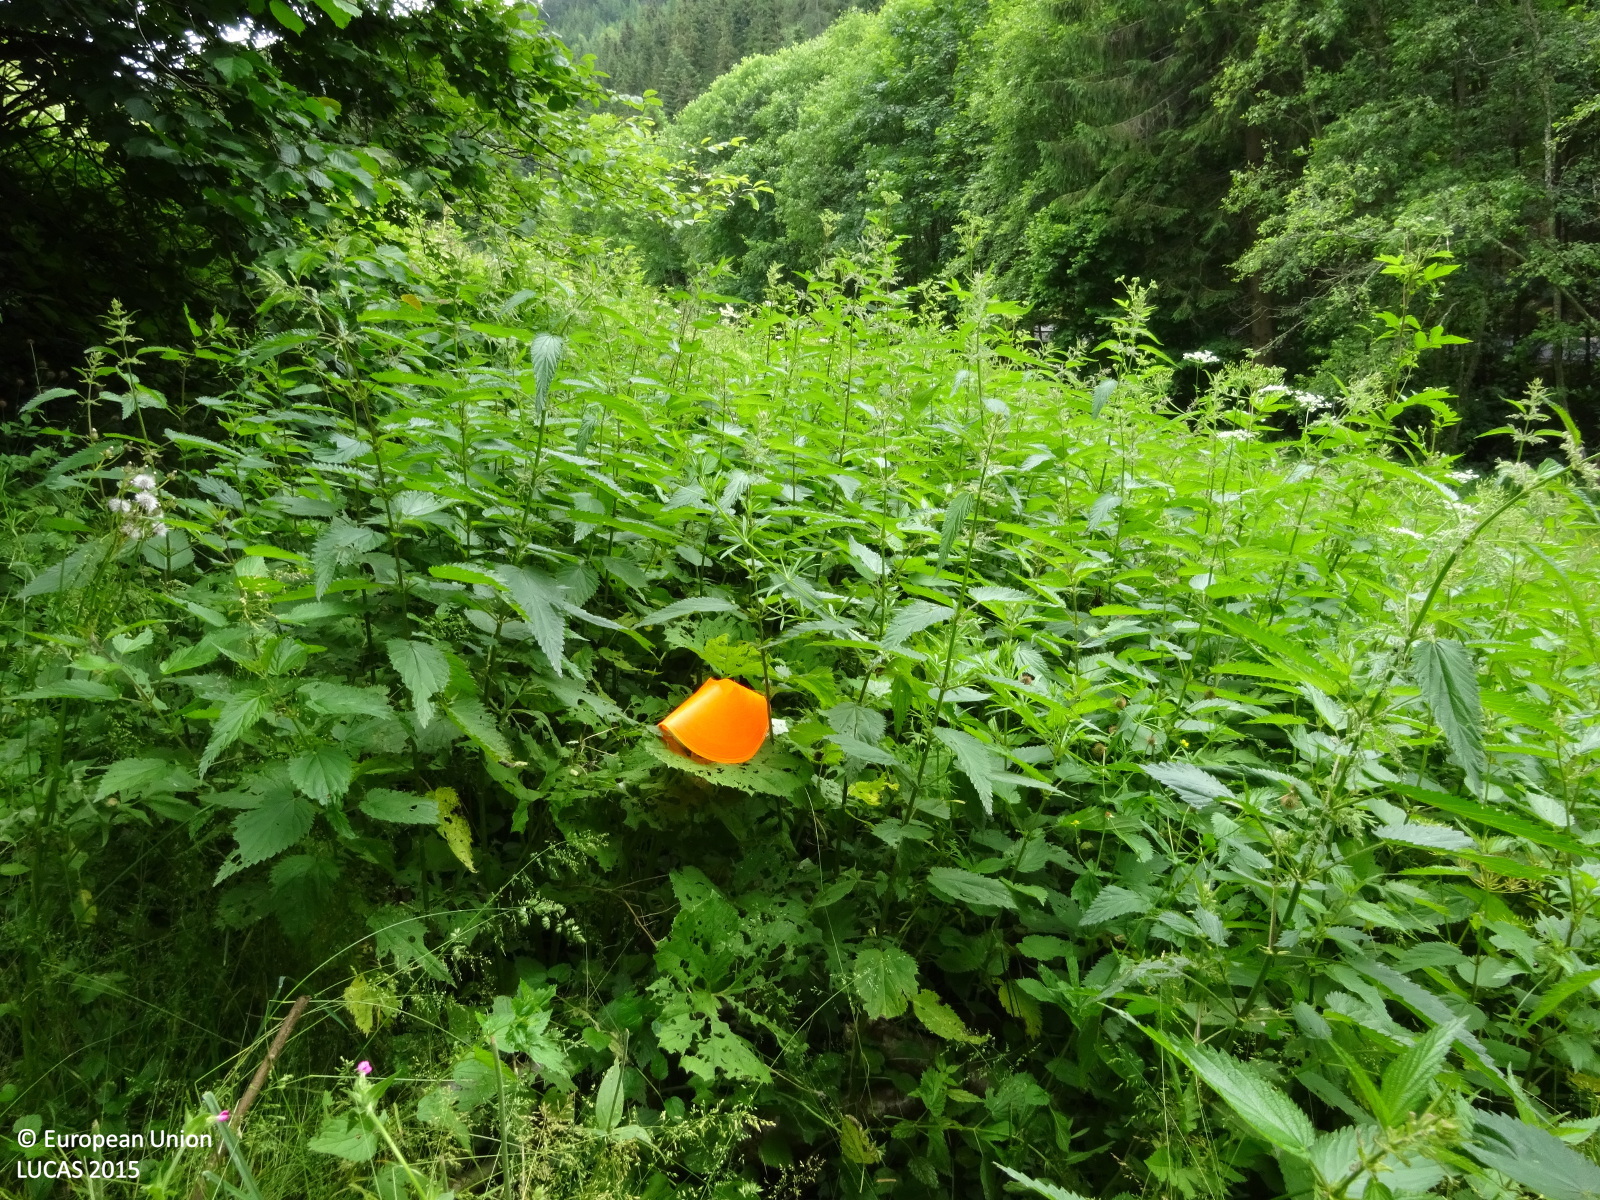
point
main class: Grassland
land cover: Grassland without tree/shrub cover
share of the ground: > 75 %
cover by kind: herbaceous plants 100 %
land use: Agriculture (excluding fallow land and kitchen gardens)
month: June
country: AT
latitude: 47.5887
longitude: 15.7063
